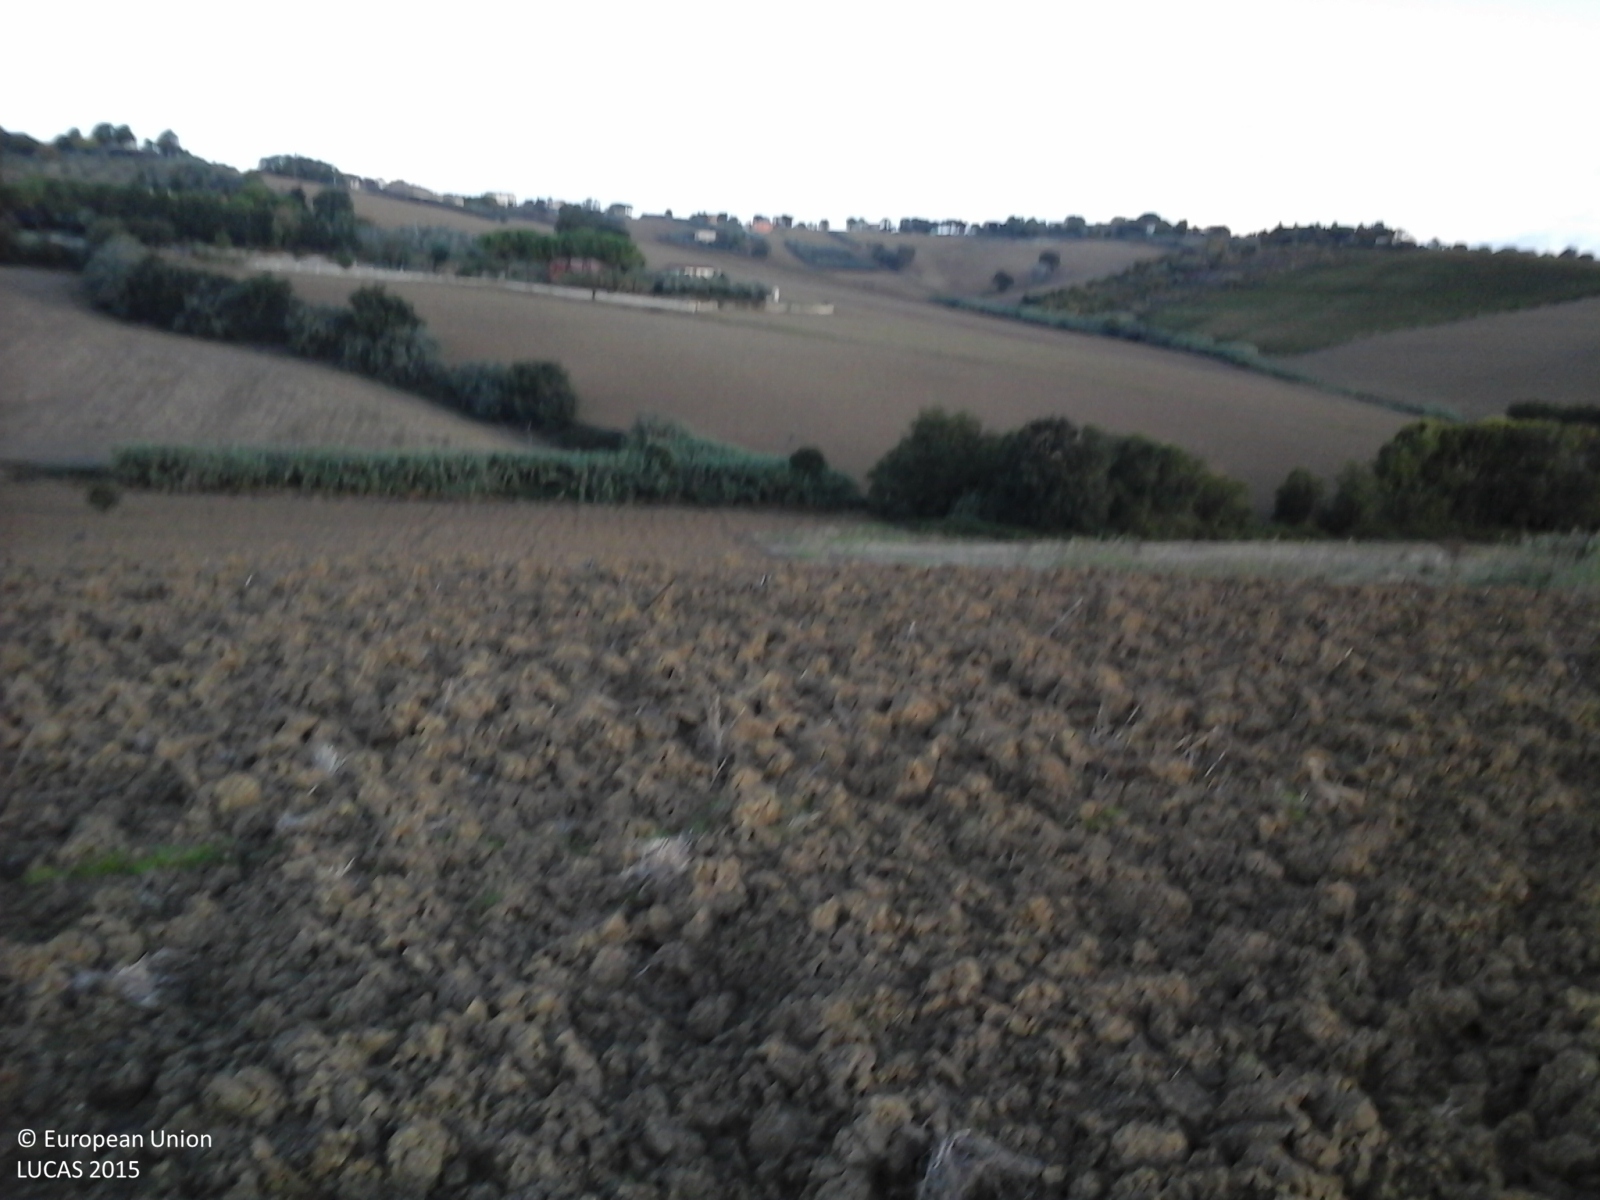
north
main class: Cropland
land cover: Durum wheat
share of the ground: < 10 %
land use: Agriculture (excluding fallow land and kitchen gardens)
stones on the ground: < 10 %
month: October
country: IT
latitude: 43.5963
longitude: 13.2252
